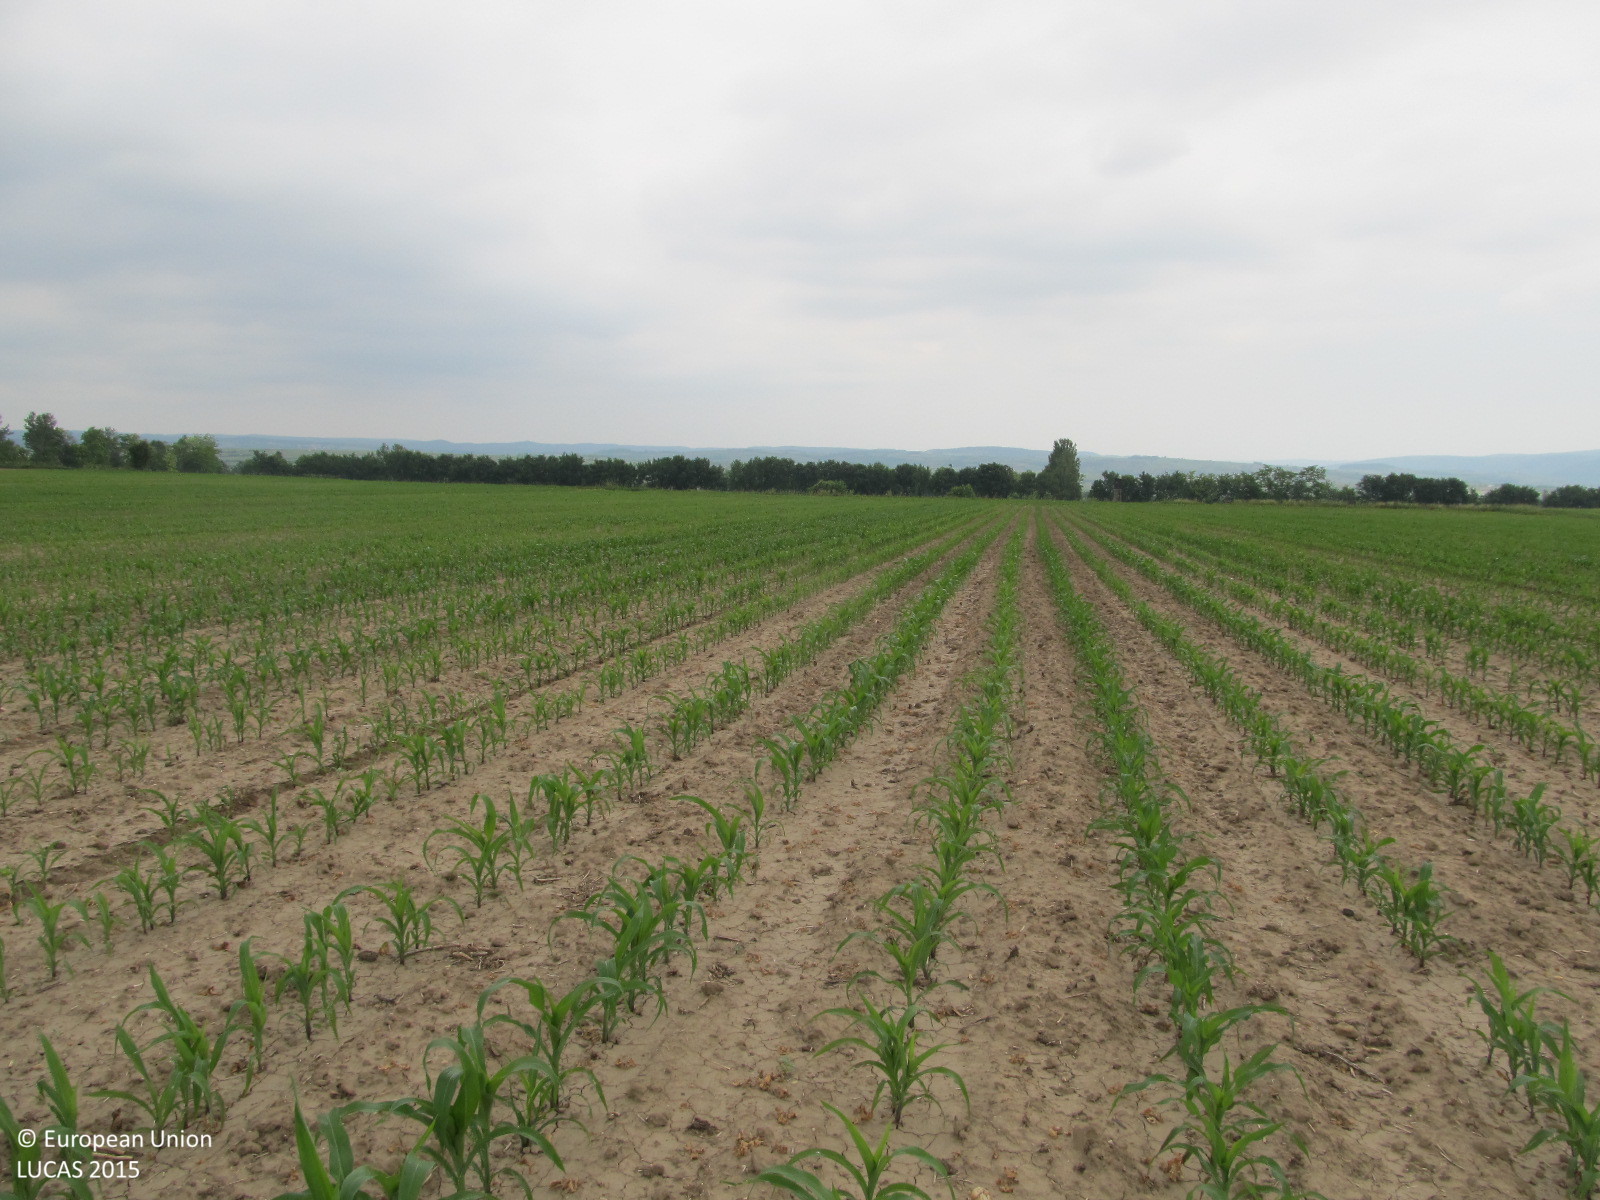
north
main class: Cropland
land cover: Maize
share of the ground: < 10 %
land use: Agriculture (excluding fallow land and kitchen gardens)
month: June
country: AT
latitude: 48.4399
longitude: 15.6400
